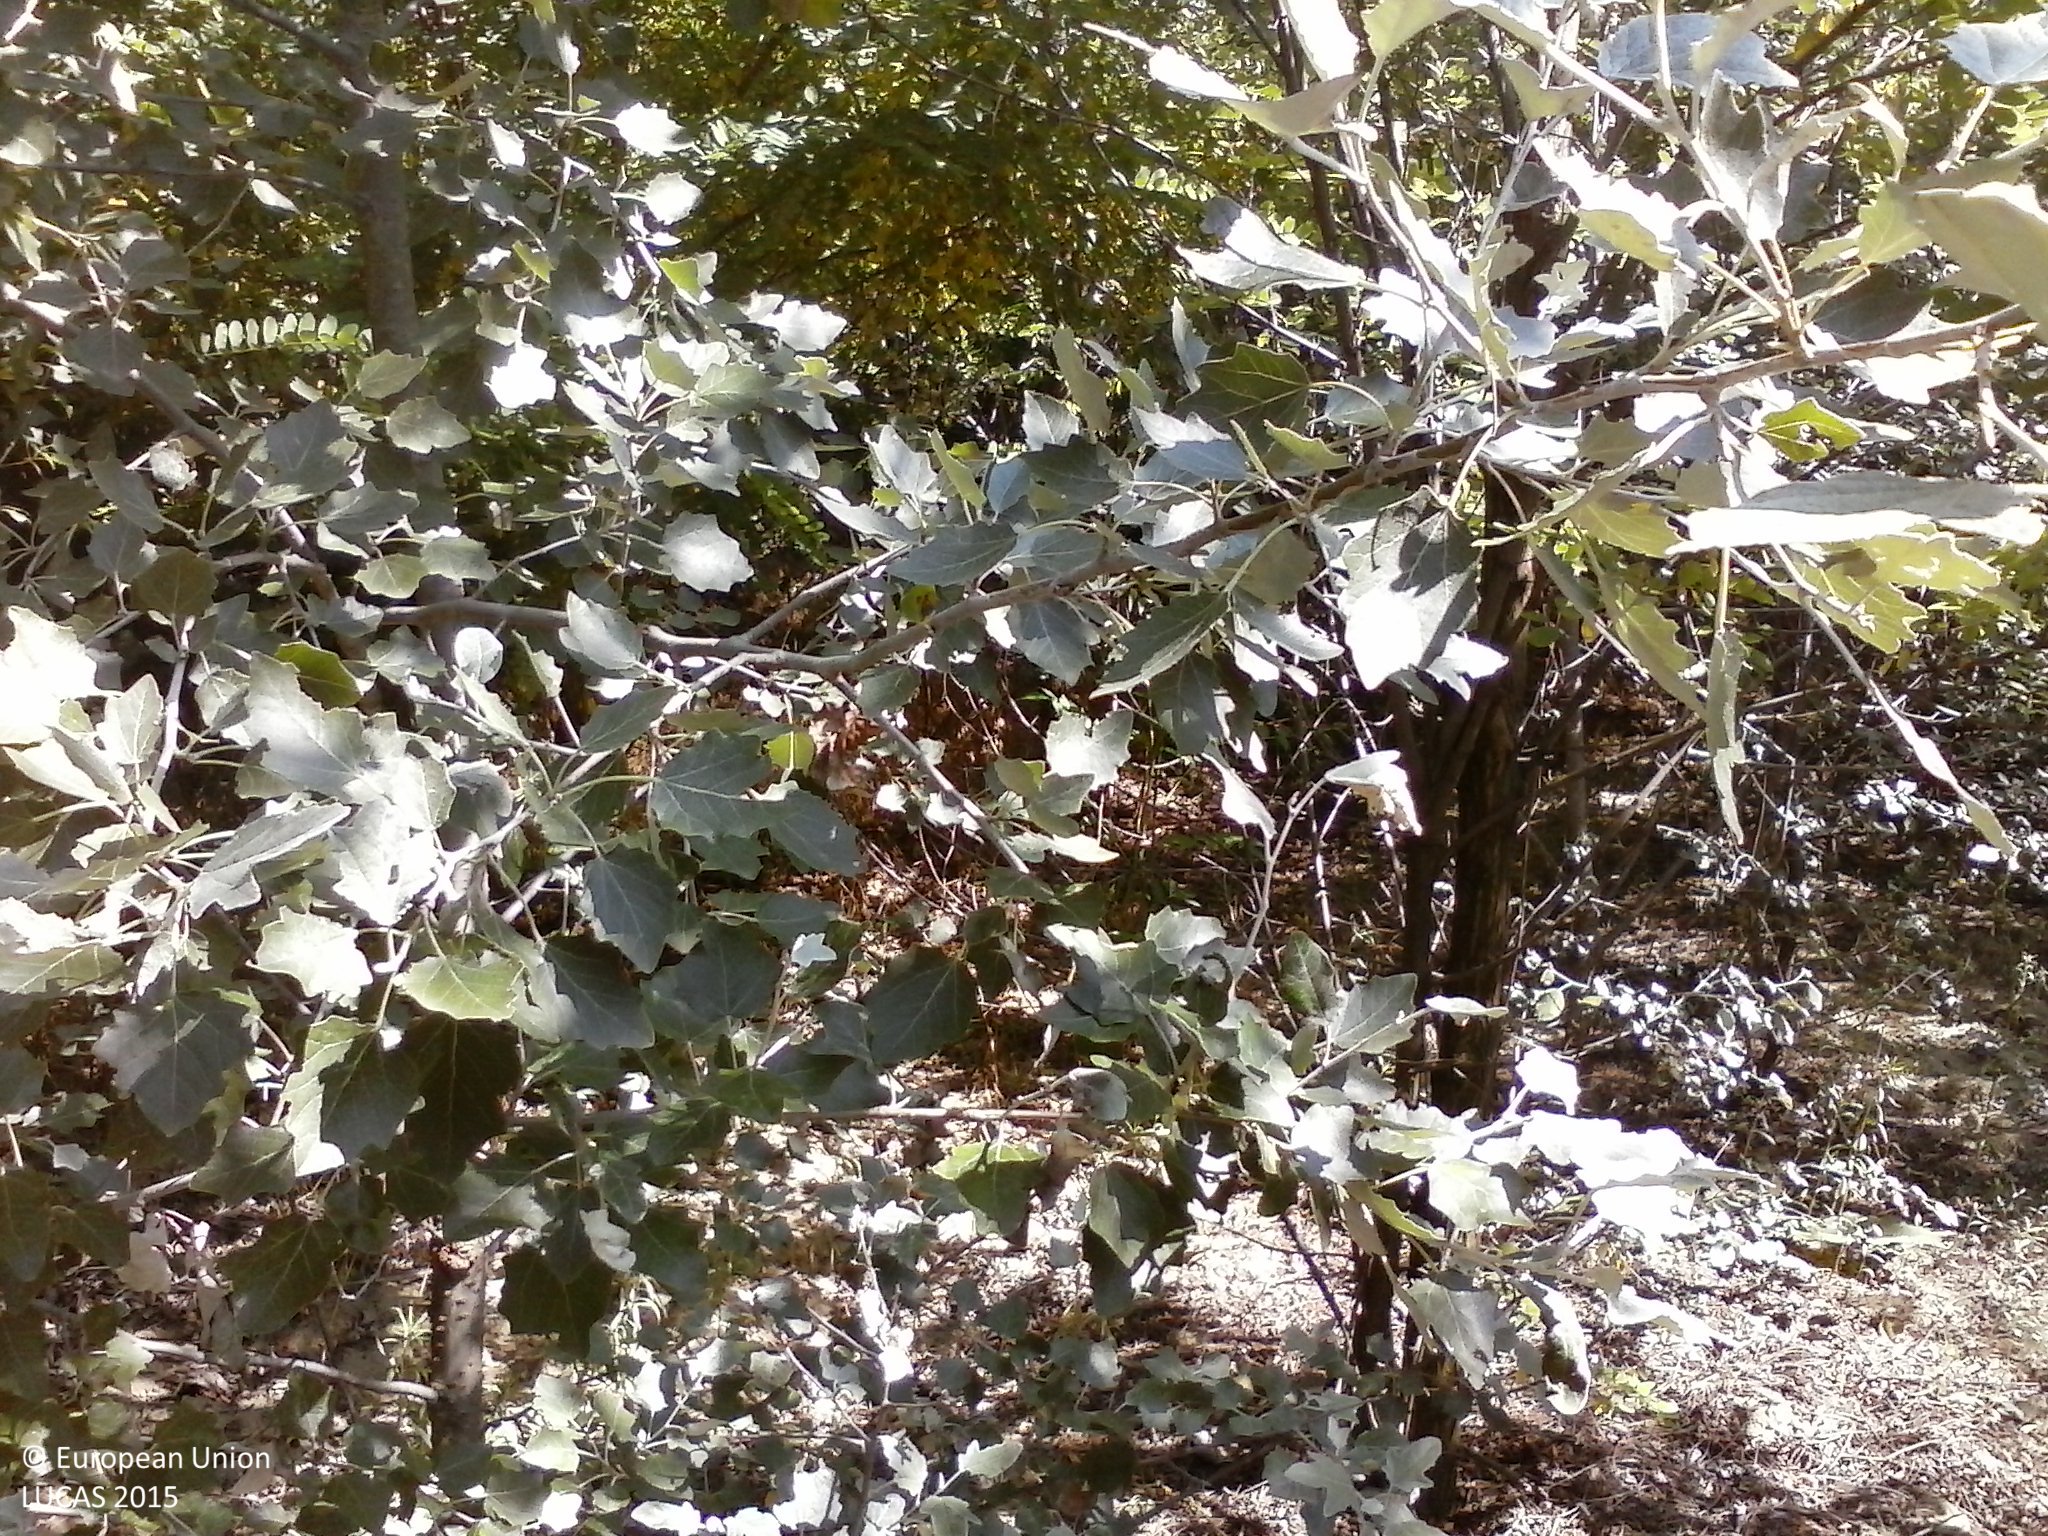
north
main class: Woodland
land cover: Broadleaved woodland
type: exotic forest
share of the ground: > 75 %
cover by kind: broadleaved forest trees 95 %, consolidated bare surface 5 %
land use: Forestry
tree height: < 5 m
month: July
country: HU
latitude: 46.2758
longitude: 19.6597
